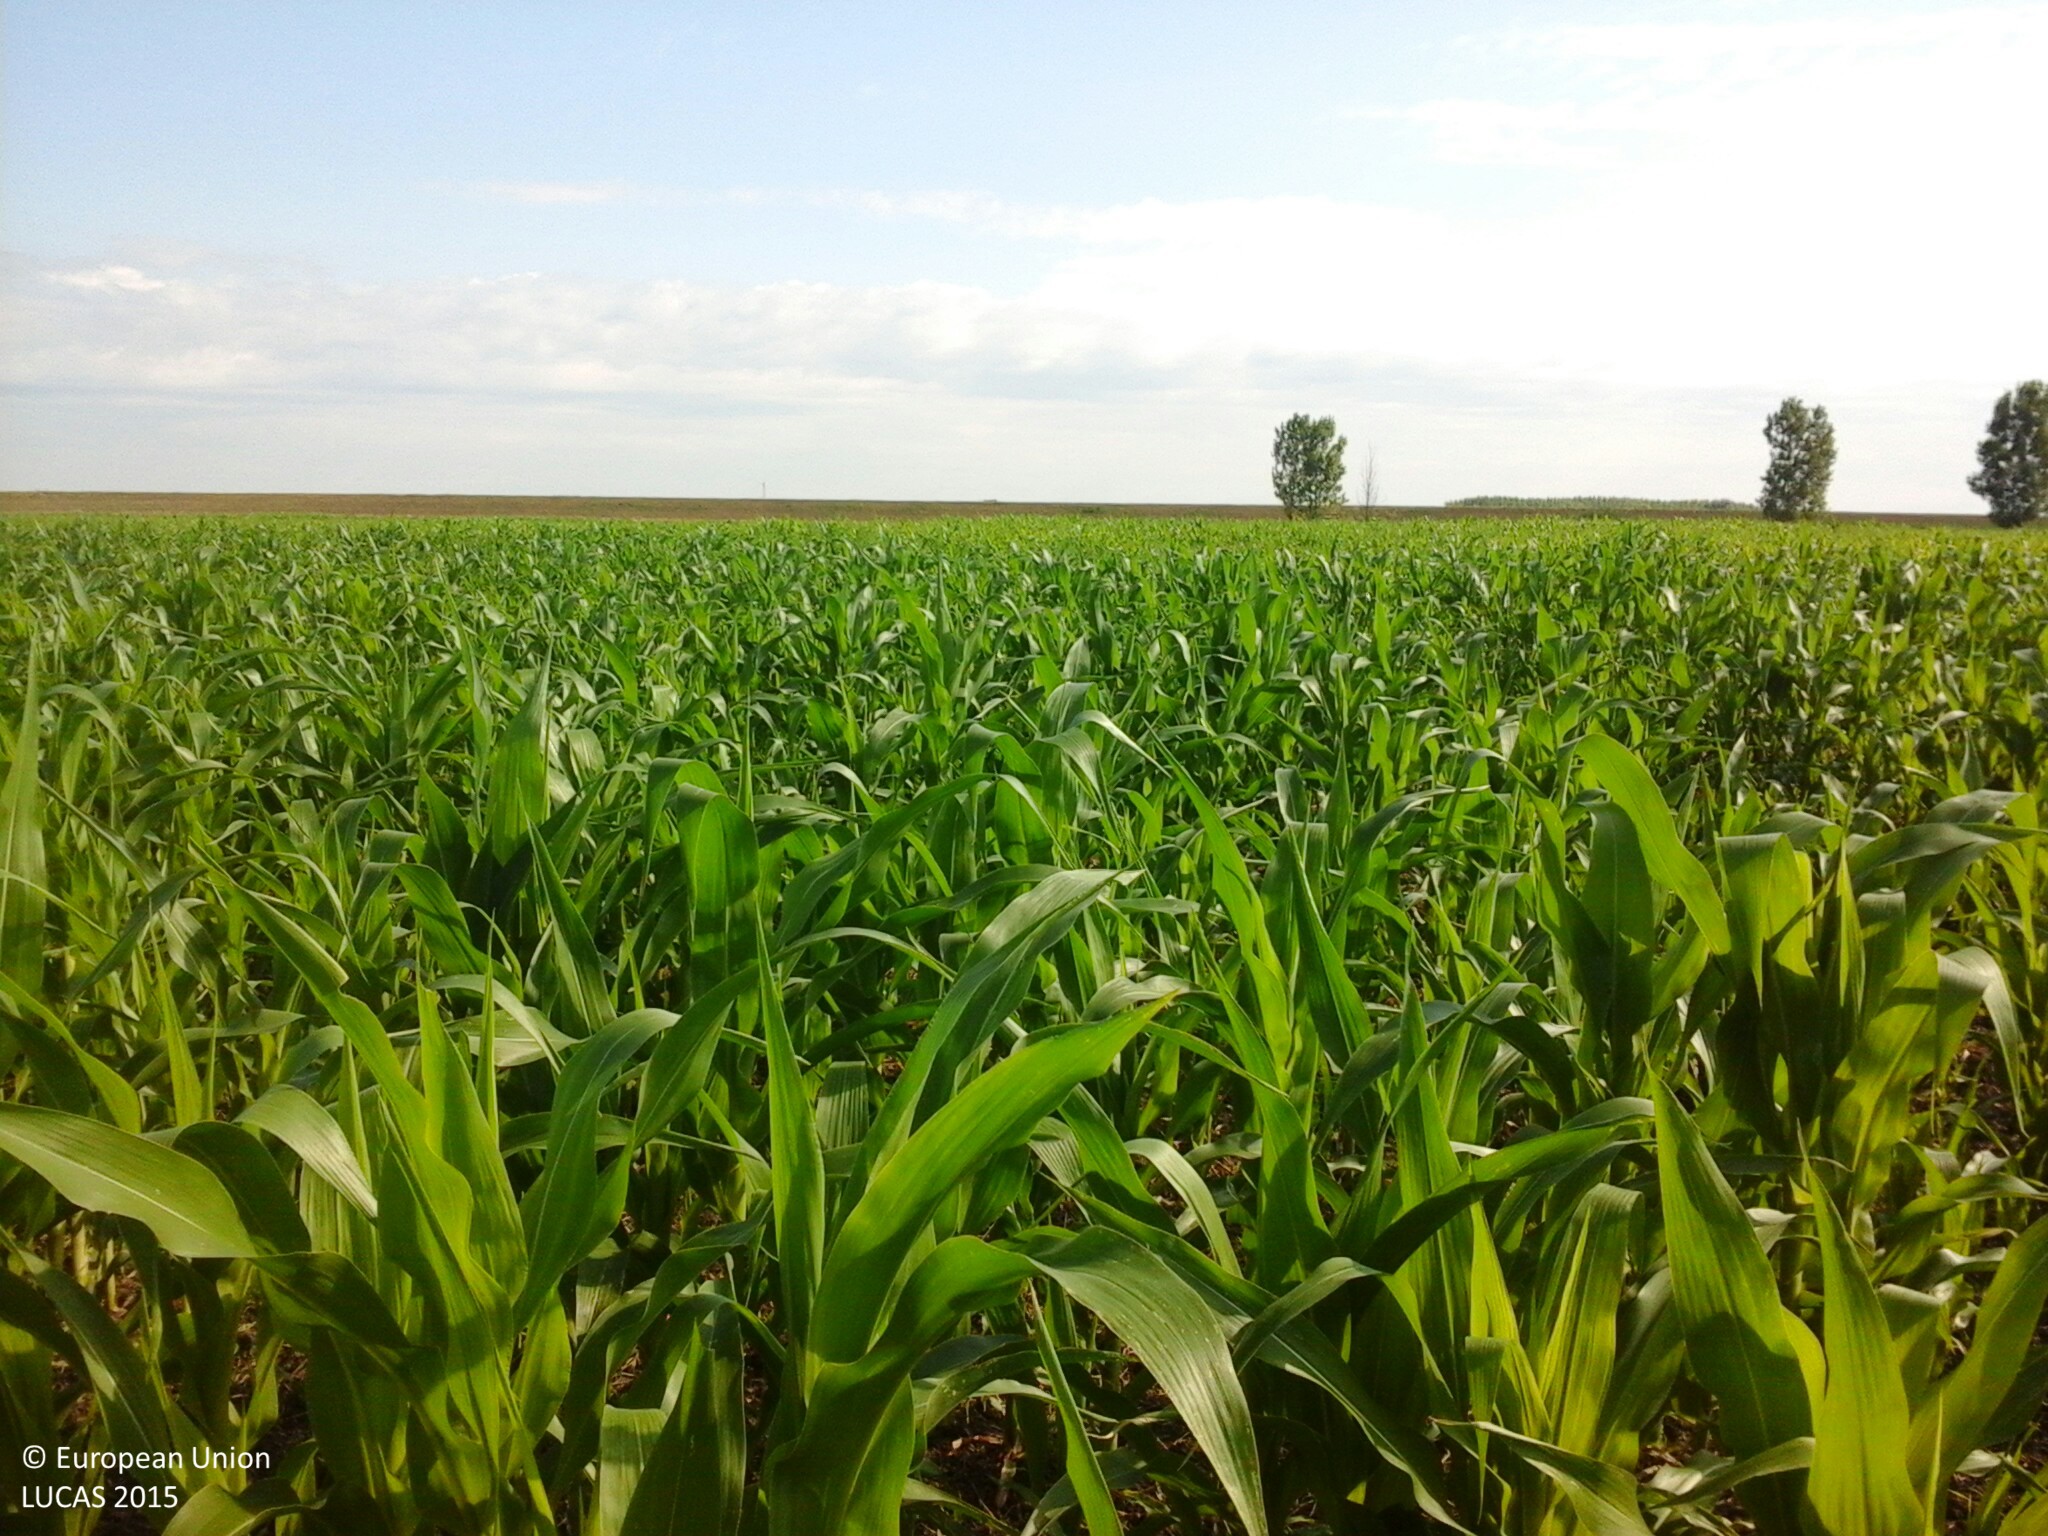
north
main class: Cropland
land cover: Maize
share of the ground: 50 - 75 %
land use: Agriculture (excluding fallow land and kitchen gardens)
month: July
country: HU
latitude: 48.0142
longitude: 22.3781
